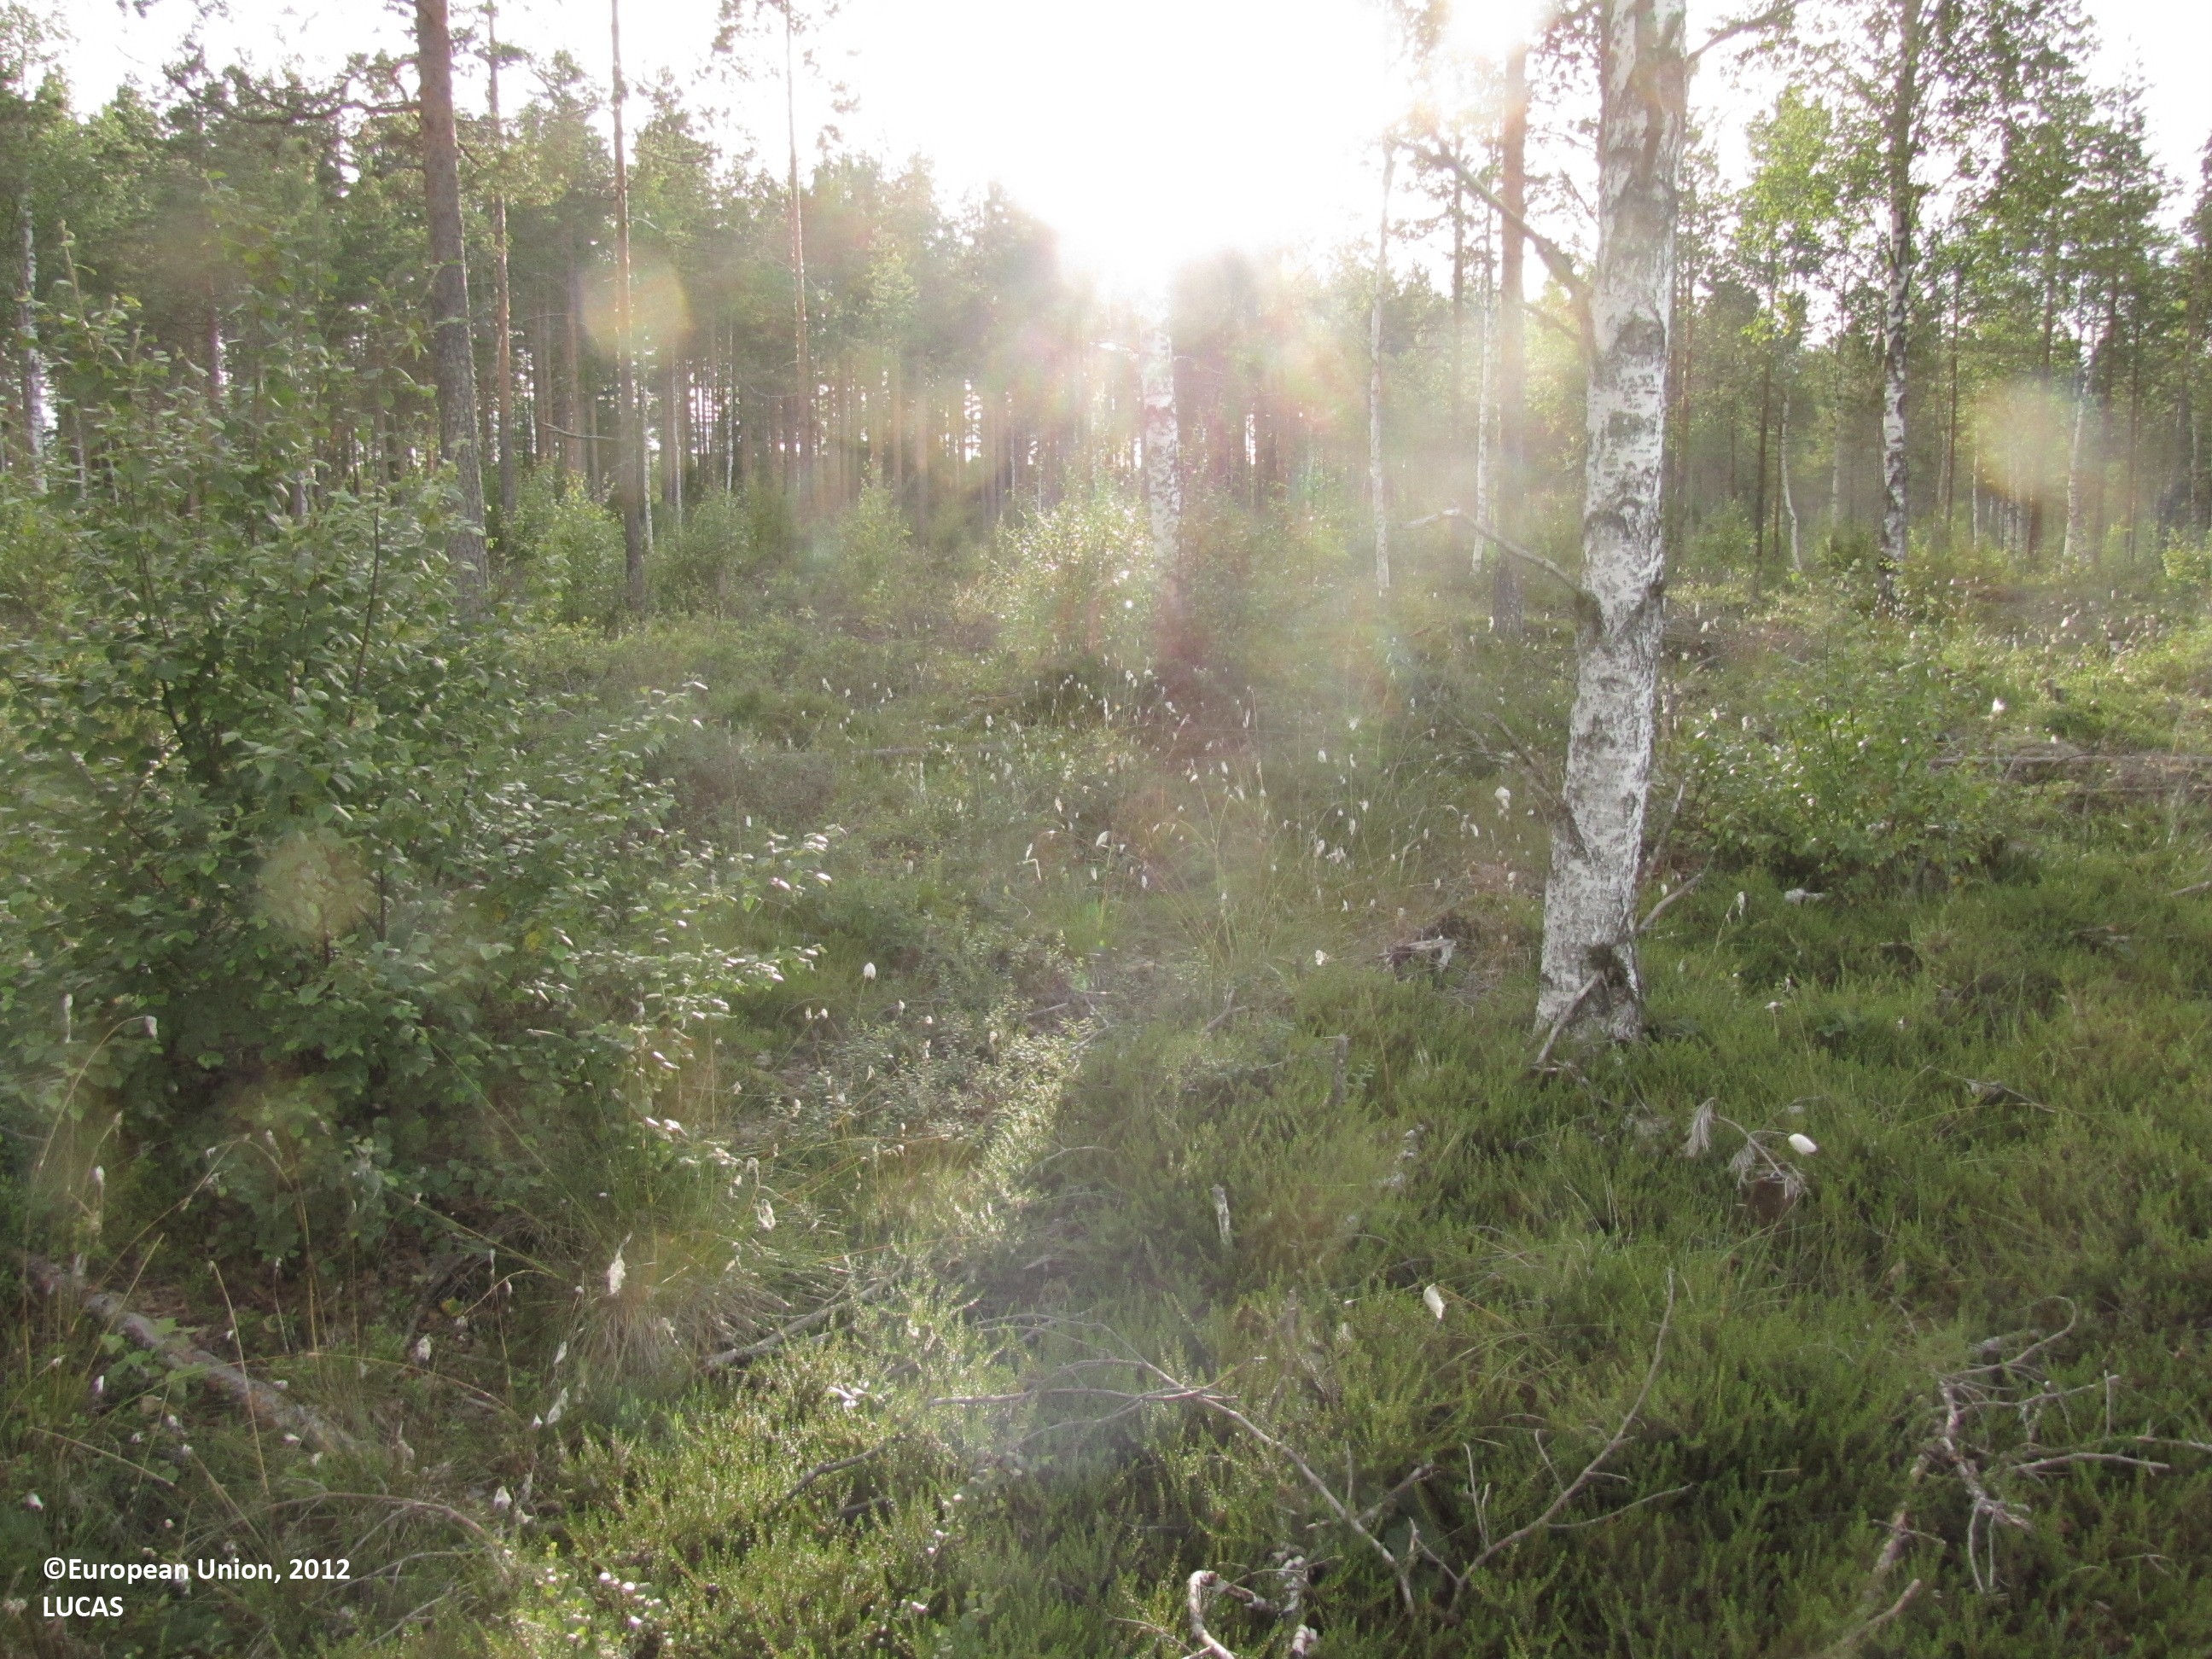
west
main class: Woodland
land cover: Pine dominated coniferous woodland
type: mire and swamp forests
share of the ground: 50 - 75 %
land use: Forestry
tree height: > 5 m
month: July
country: FI
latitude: 62.4906
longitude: 23.5597
